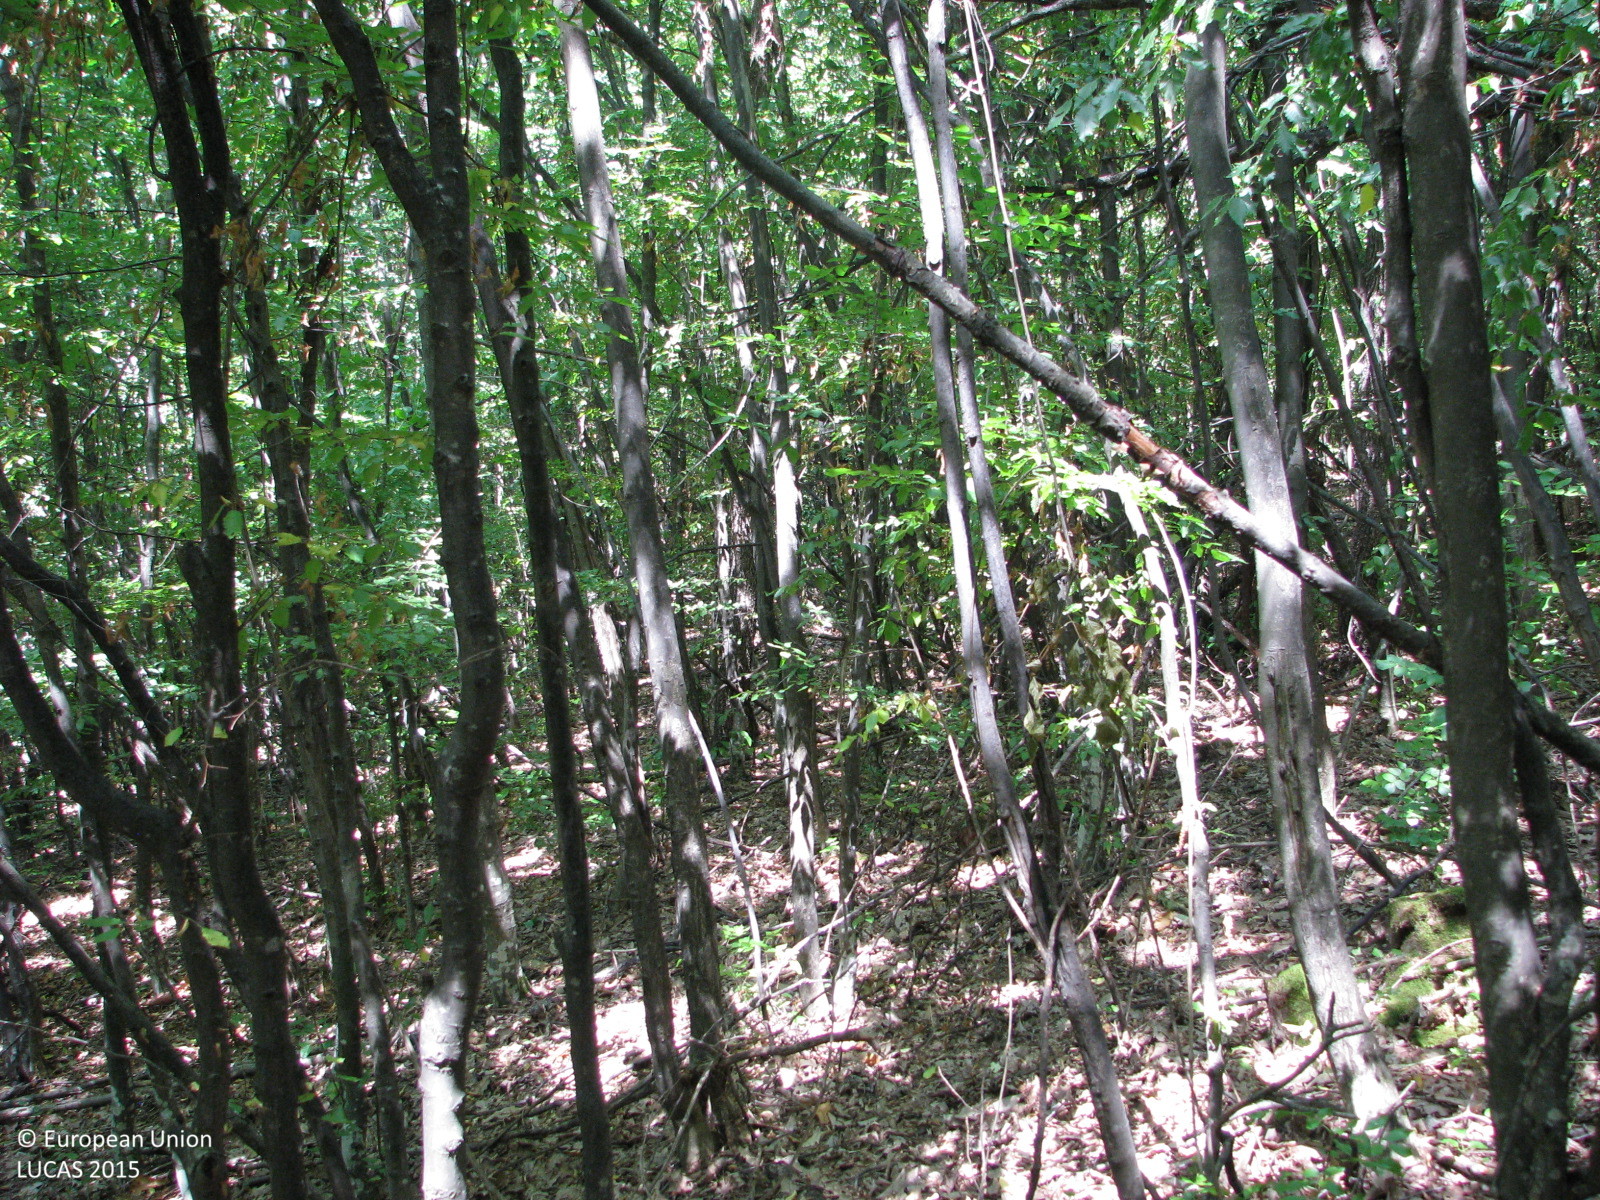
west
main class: Woodland
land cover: Broadleaved woodland
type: beech forest
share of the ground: > 75 %
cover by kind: broadleaved forest trees 85 %, unconsolidated bare surface 15 %
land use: Forestry
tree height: > 5 m
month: August
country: BG
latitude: 42.7582
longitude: 26.1804
